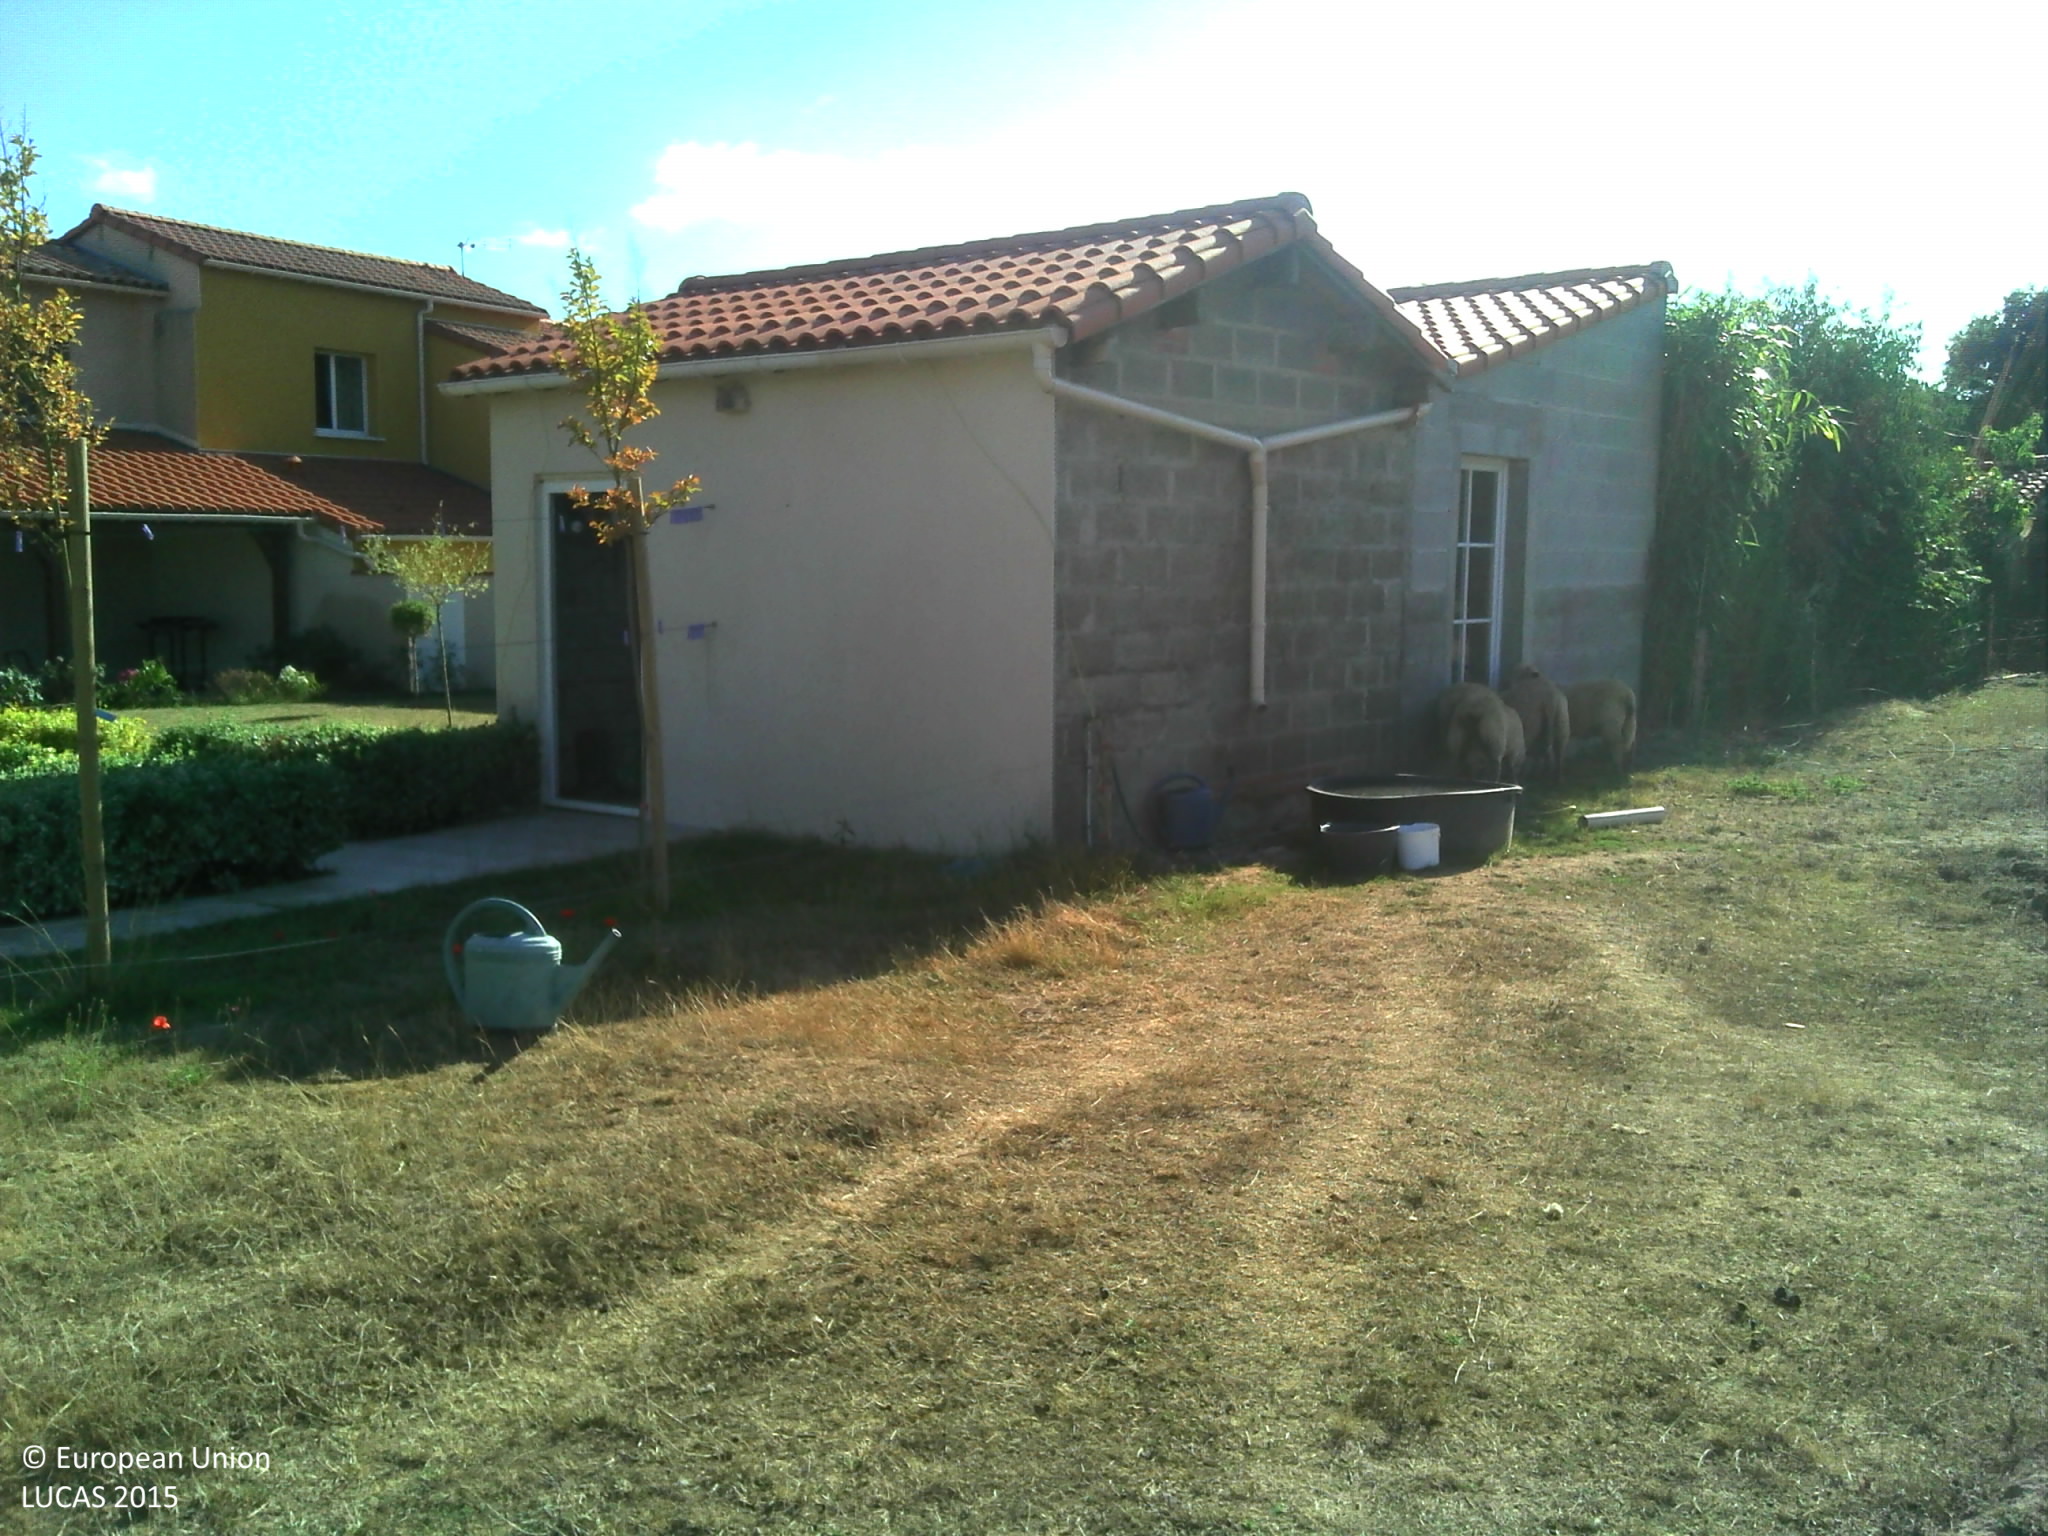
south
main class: Grassland
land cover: Grassland without tree/shrub cover
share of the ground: > 75 %
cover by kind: herbaceous plants 95 %, shrubs 5 %
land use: Residential
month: August
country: FR
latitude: 46.6767
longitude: -1.1329
